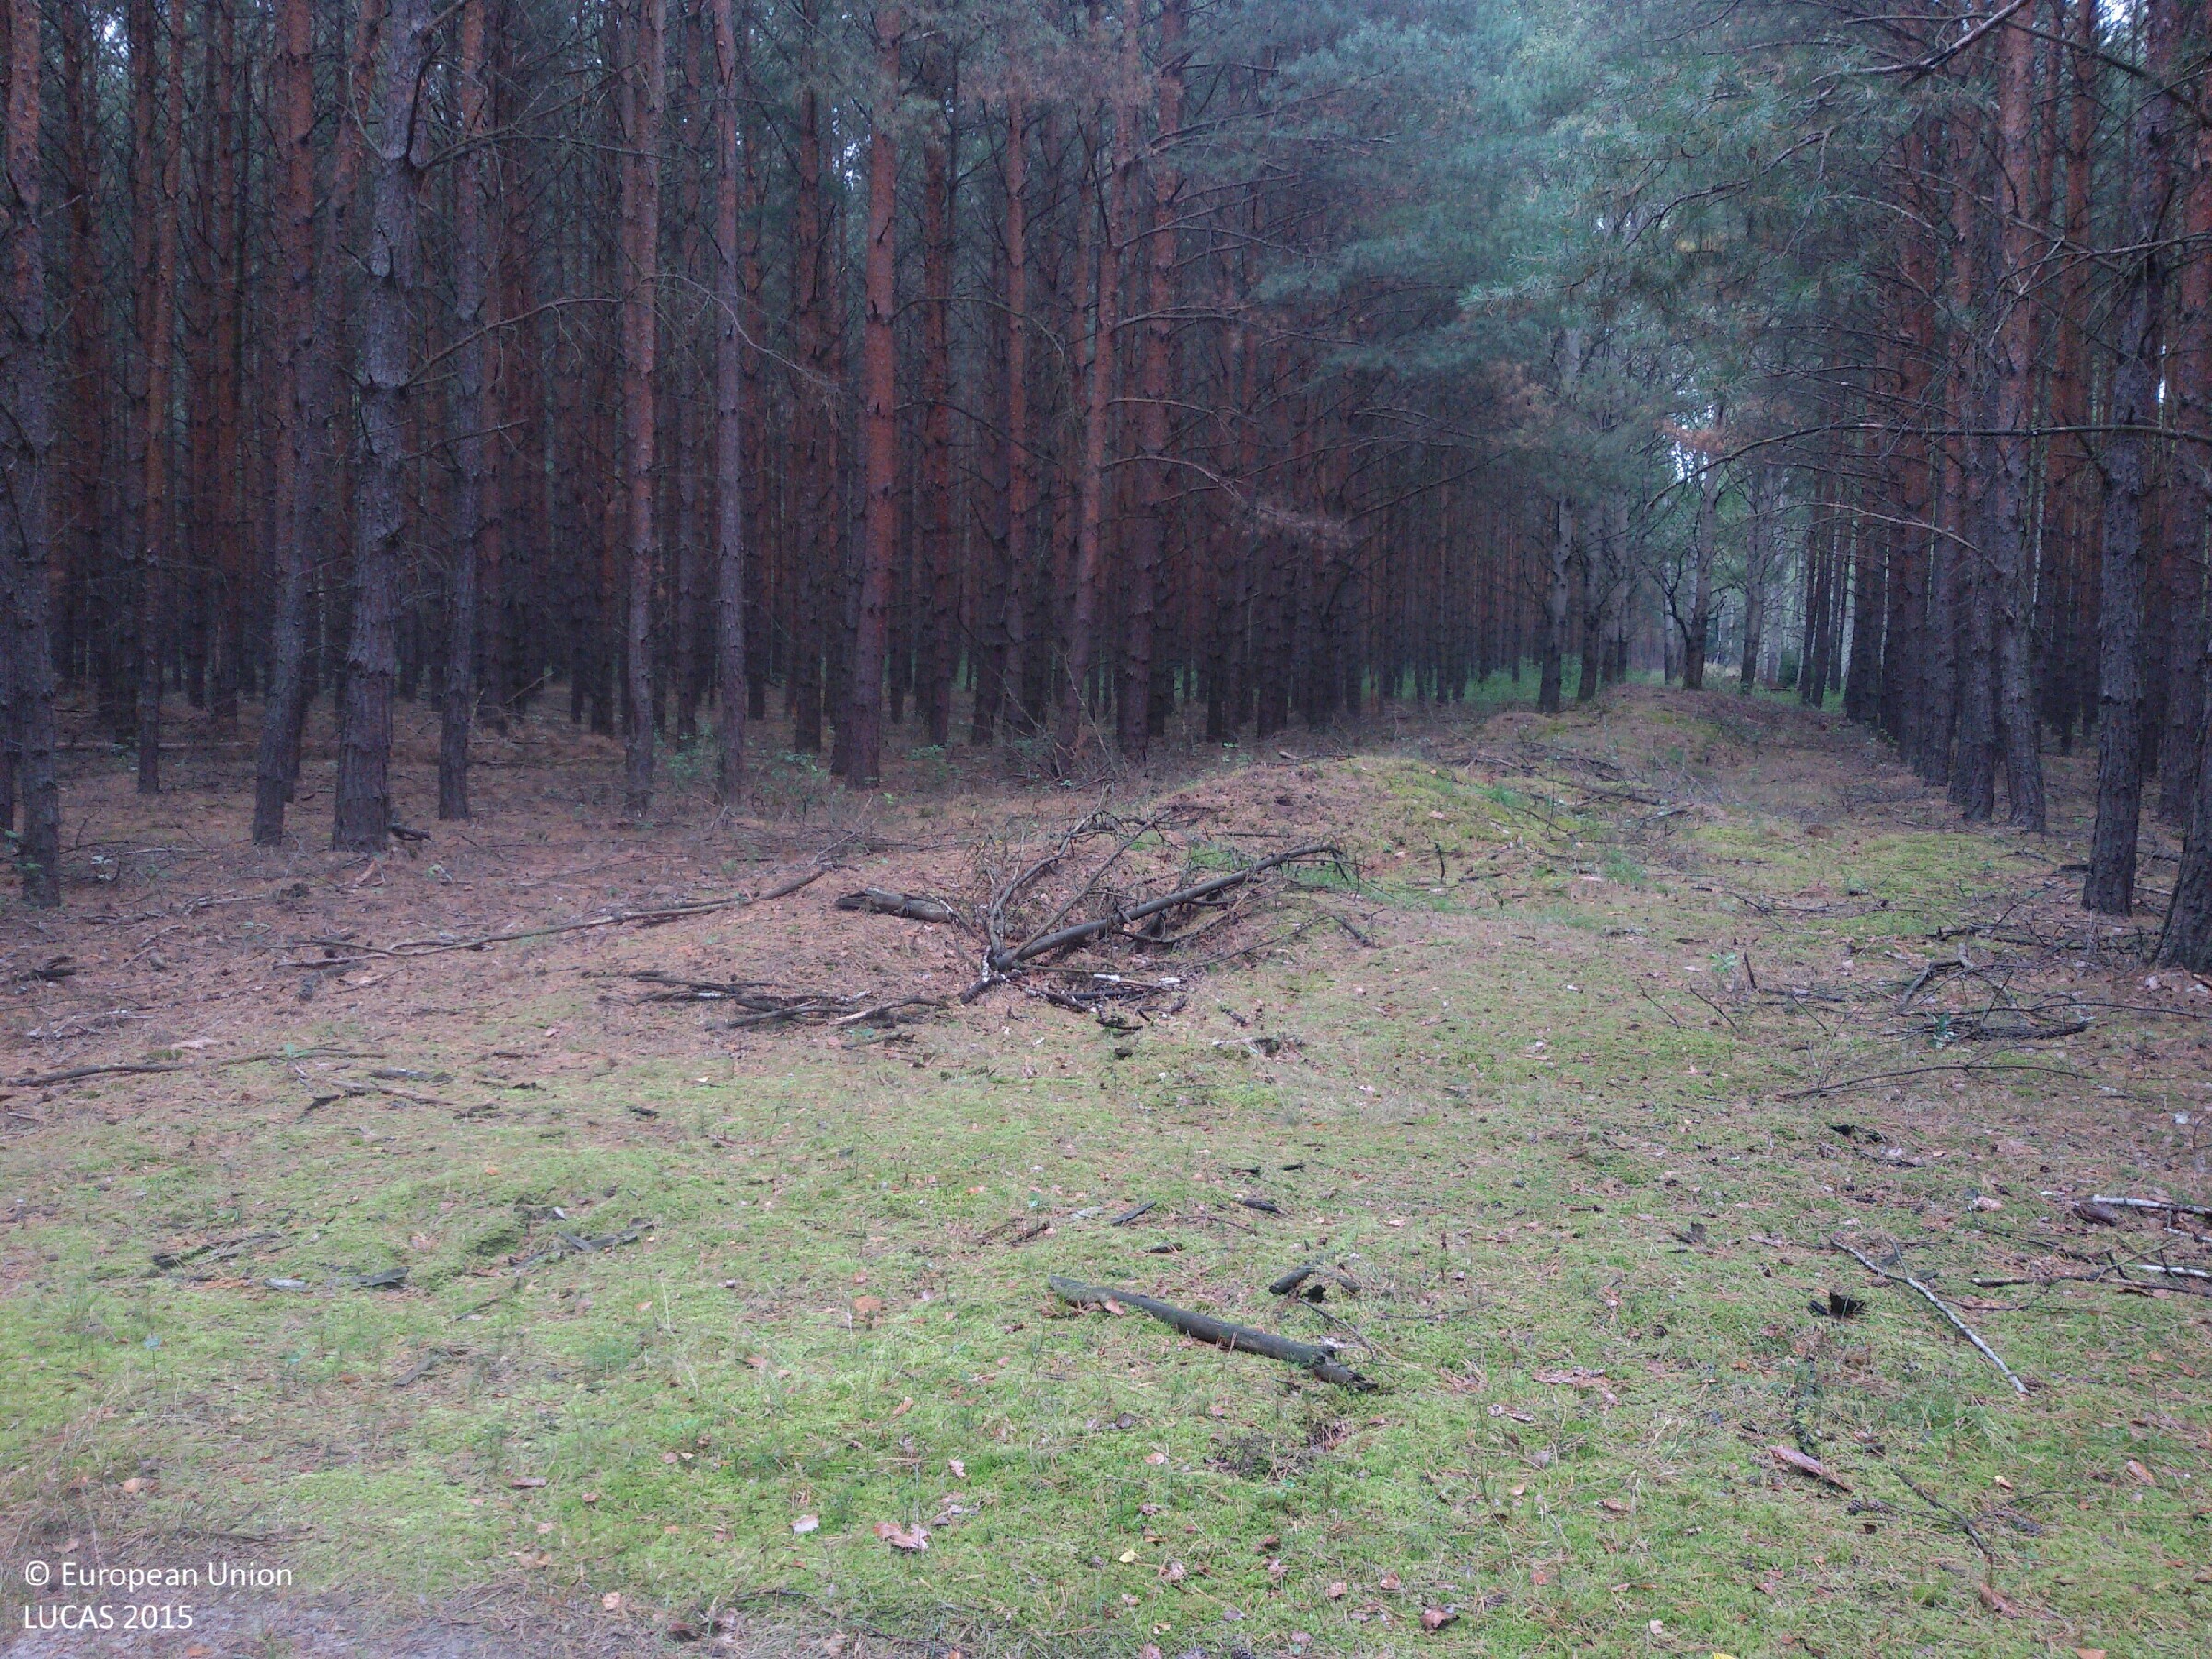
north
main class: Woodland
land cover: Pine dominated coniferous woodland
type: hemiboreal forest and nemoral coniferous forest and mixed broadleaved-coniferous forest
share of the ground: > 75 %
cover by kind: coniferous forest trees 85 %, lichens and mosses 10 %, broadleaved forest trees 5 %
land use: Forestry
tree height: > 5 m
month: September
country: PL
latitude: 51.7271
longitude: 14.6784
